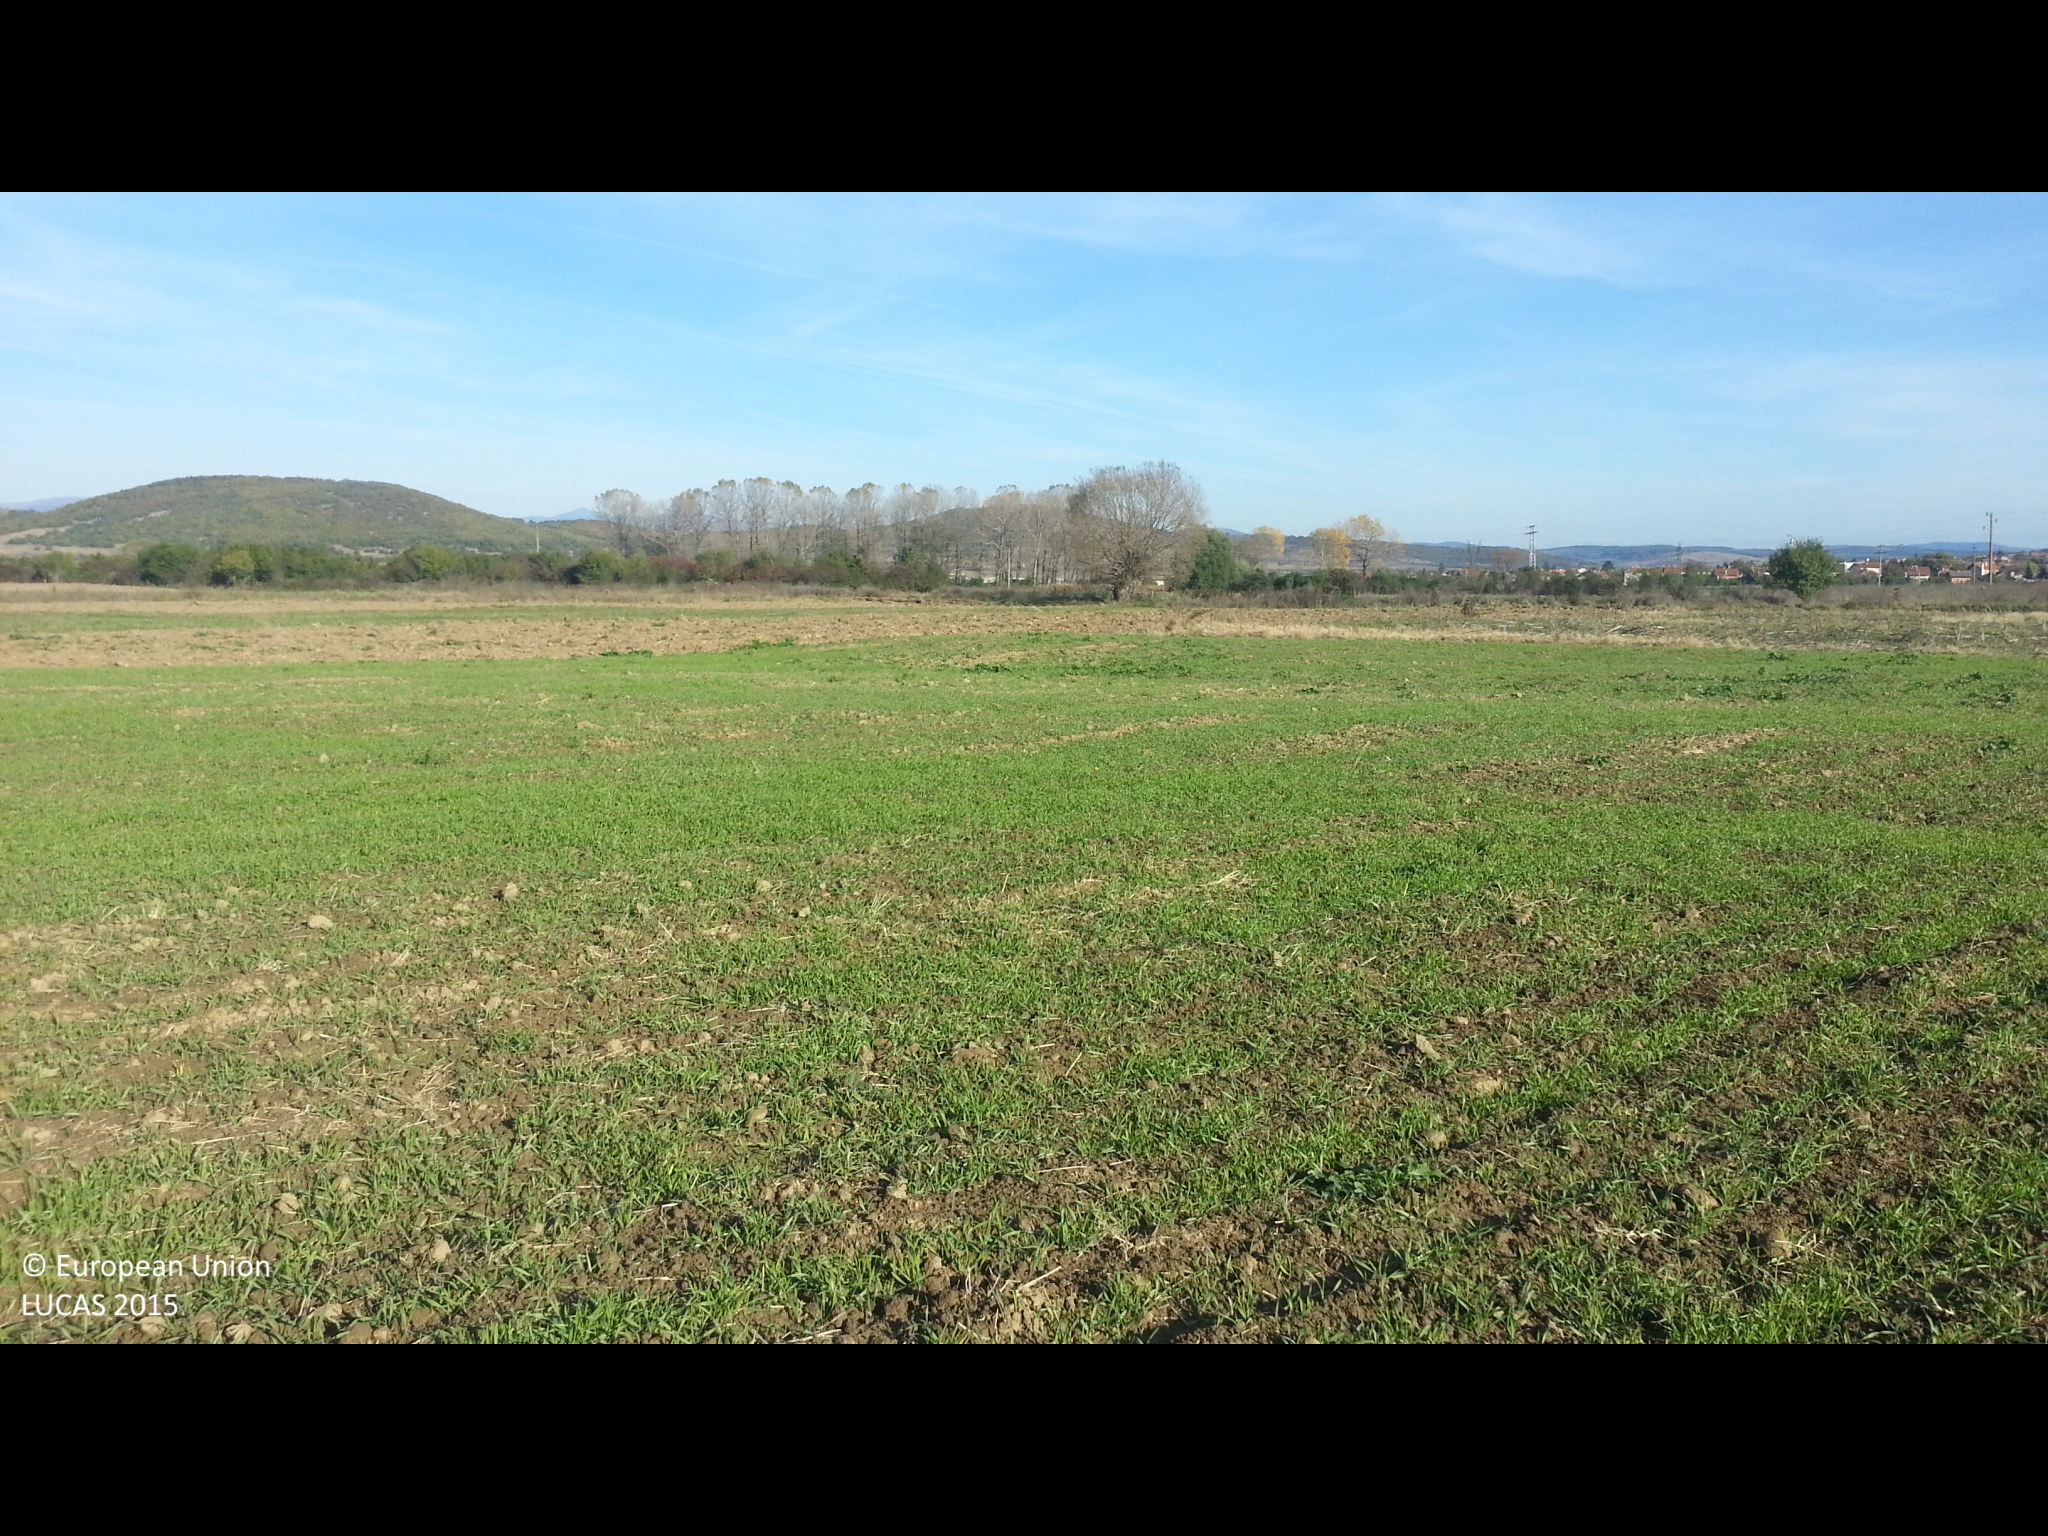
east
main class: Cropland
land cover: Common wheat
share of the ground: 10 - 25 %
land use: Agriculture (excluding fallow land and kitchen gardens)
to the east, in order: Common wheat; Grassland without tree/shrub cover; Single bushes/trees; Grassland without tree/shrub cover
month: October
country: BG
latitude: 42.6734
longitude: 23.6692
